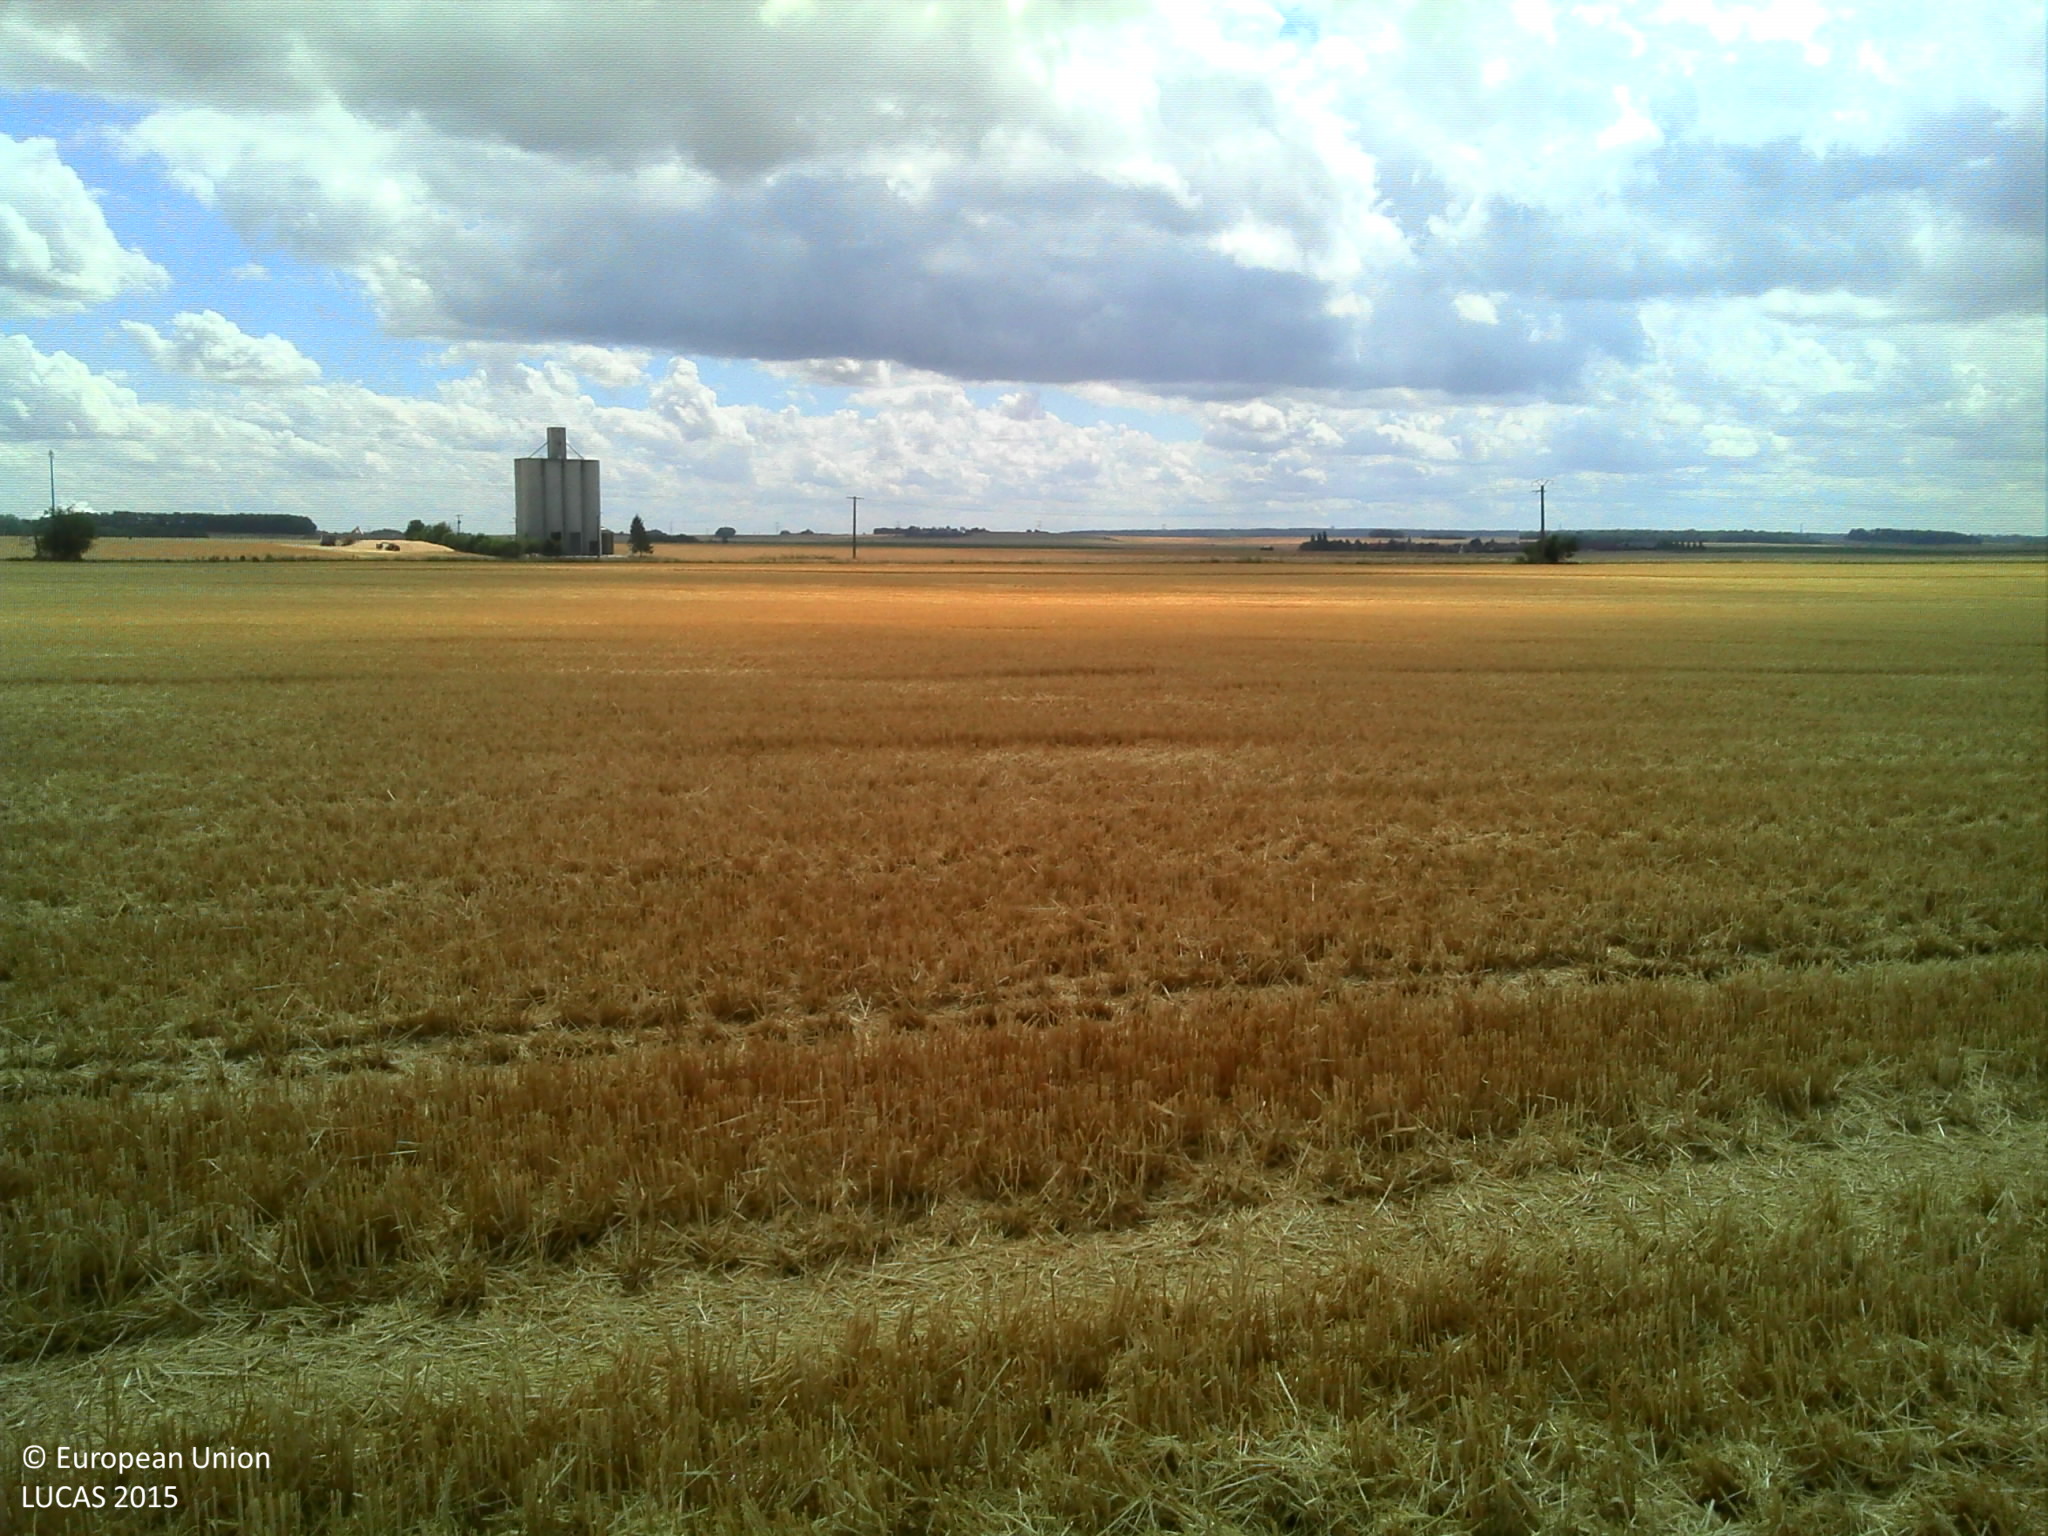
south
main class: Cropland
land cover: Barley
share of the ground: > 75 %
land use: Agriculture (excluding fallow land and kitchen gardens)
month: August
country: FR
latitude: 48.6059
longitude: 3.4431
